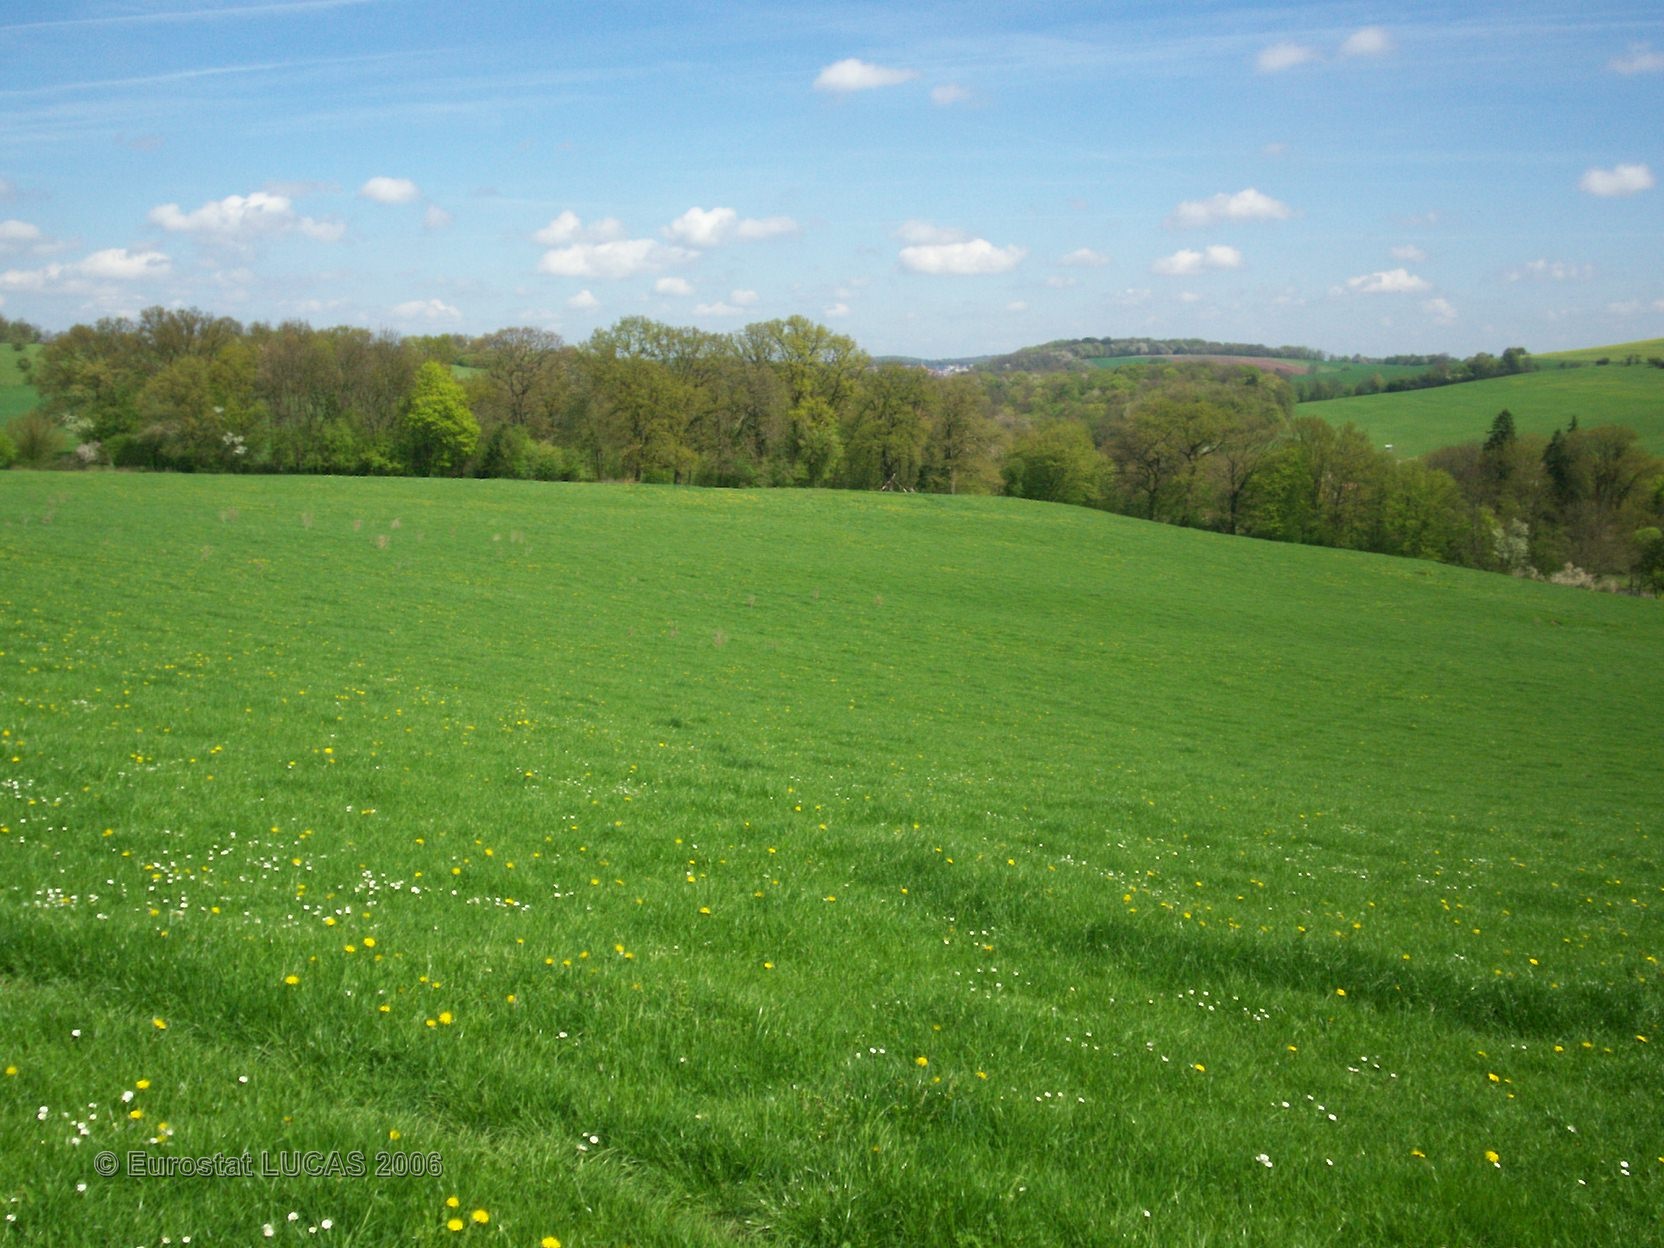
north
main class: Grassland
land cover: Grassland without tree/shrub cover
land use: Agriculture (excluding fallow land and kitchen gardens)
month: May
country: FR
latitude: 49.1129
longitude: 6.7808
